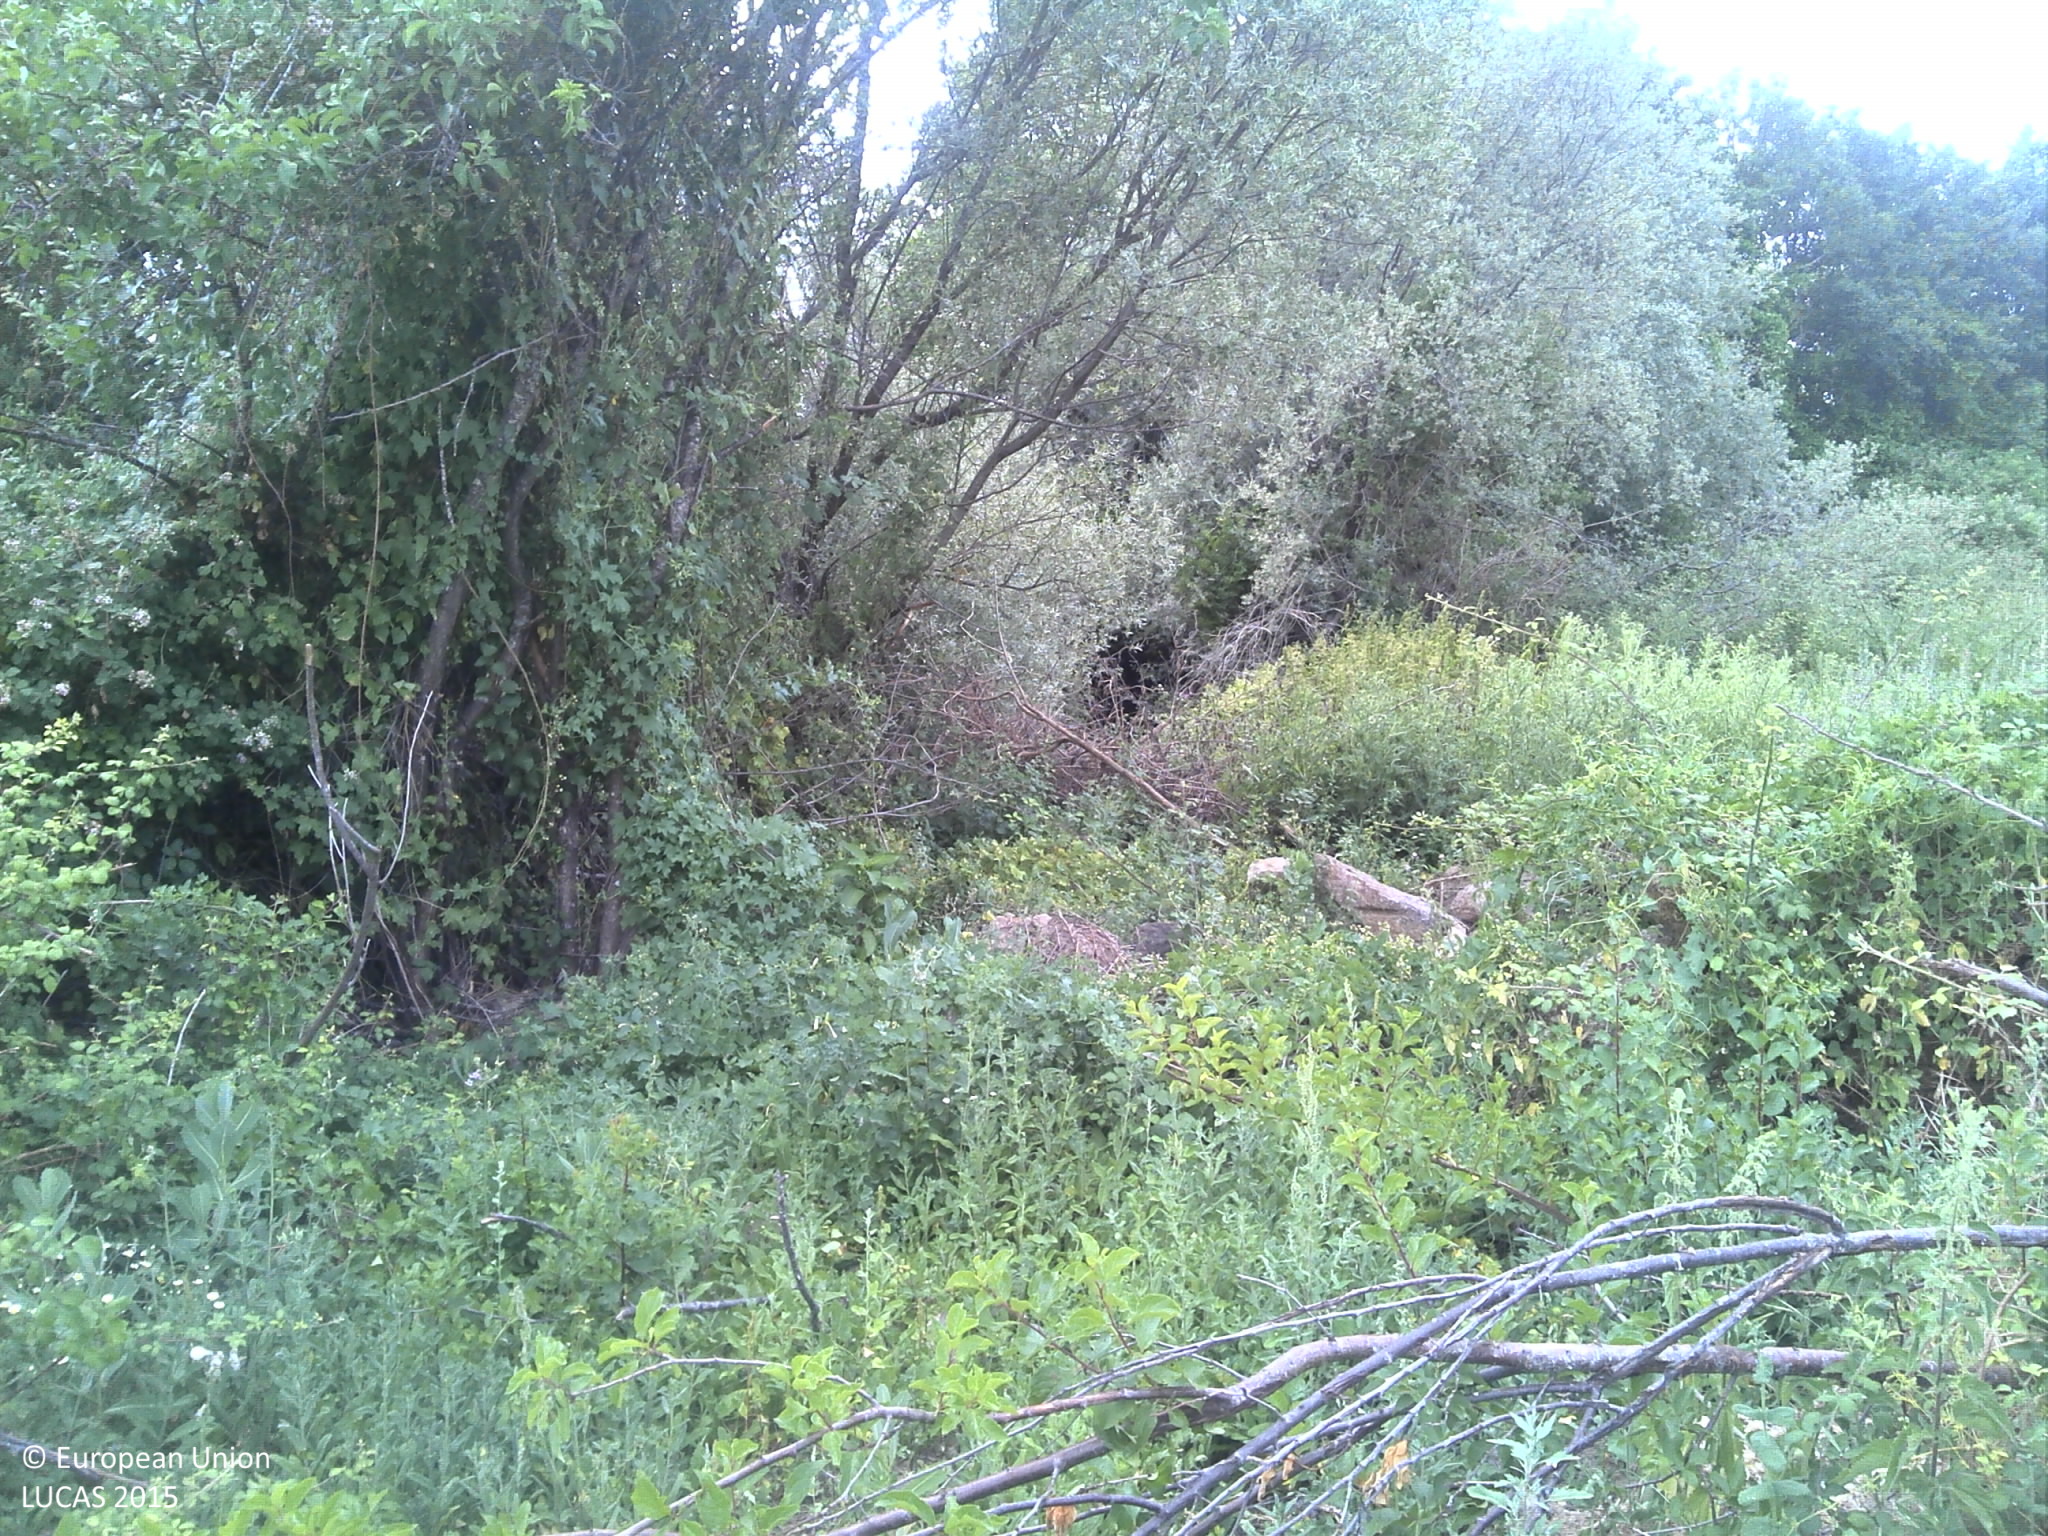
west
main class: Shrubland
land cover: Shrubland without tree cover
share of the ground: 50 - 75 %
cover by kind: shrubs 60 %, herbaceous plants 25 %, unconsolidated bare surface 10 %
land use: Agriculture (excluding fallow land and kitchen gardens)
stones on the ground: 10 - 25 %
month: June
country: PT
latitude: 40.2619
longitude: -7.3286
